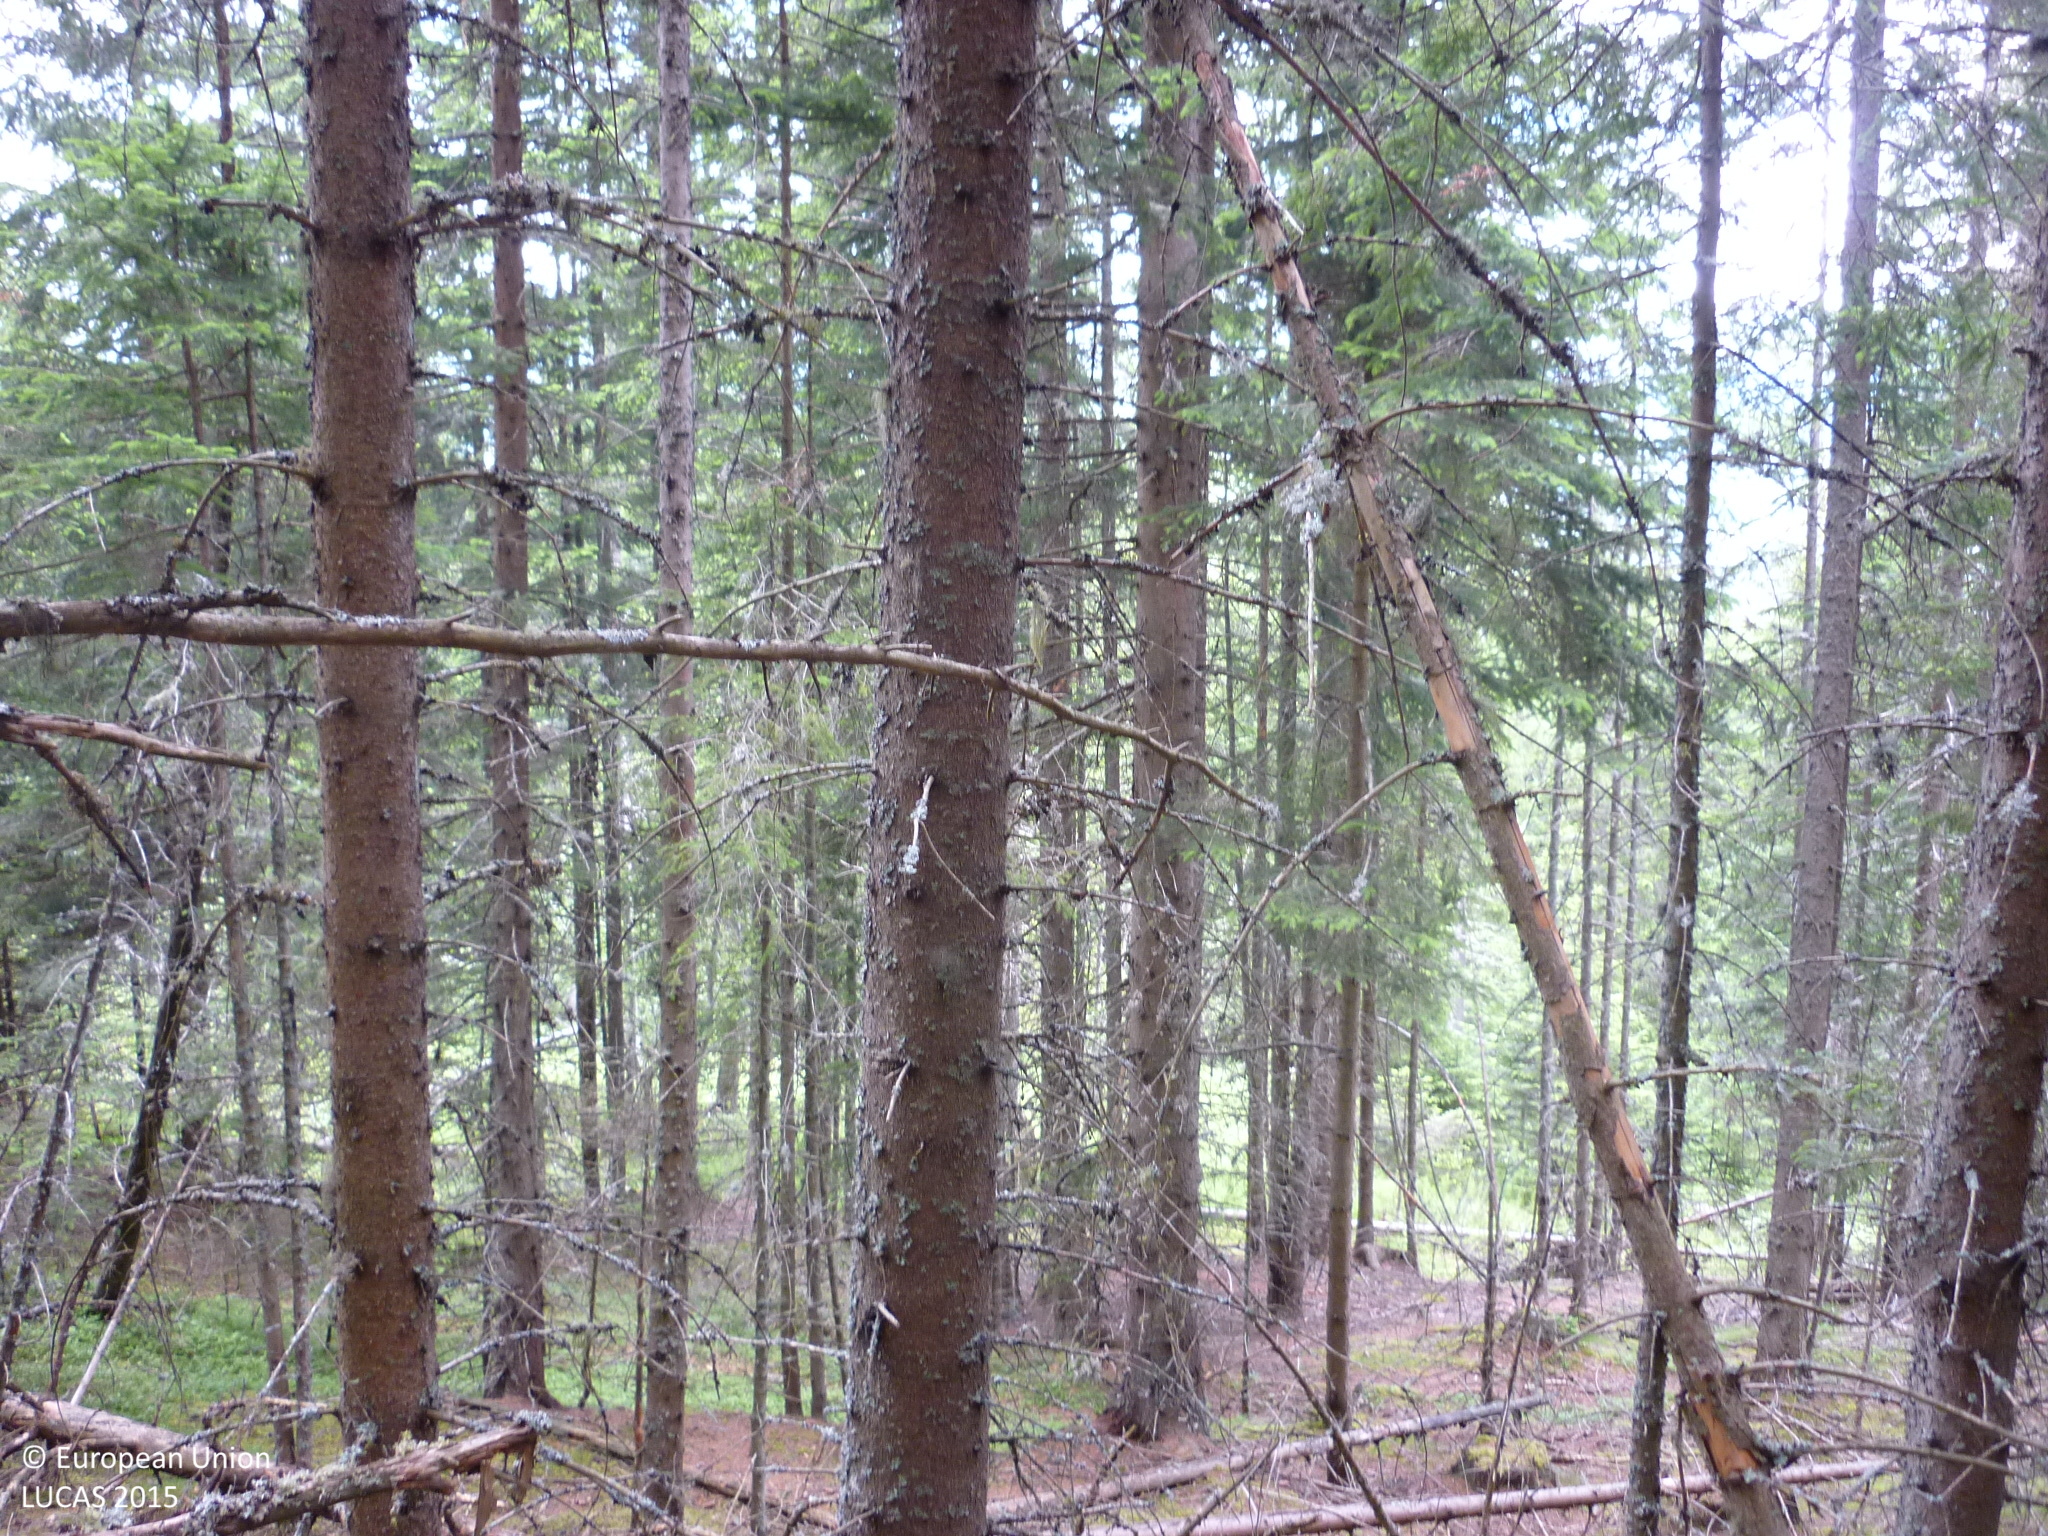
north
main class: Woodland
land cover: Spruce dominated coniferous woodland
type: alpine coniferous forest
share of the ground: > 75 %
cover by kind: coniferous forest trees 90 %, herbaceous plants 5 %, unconsolidated bare surface 5 %
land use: Forestry
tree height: > 5 m
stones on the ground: < 10 %
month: June
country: AT
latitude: 47.1860
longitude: 14.2610
